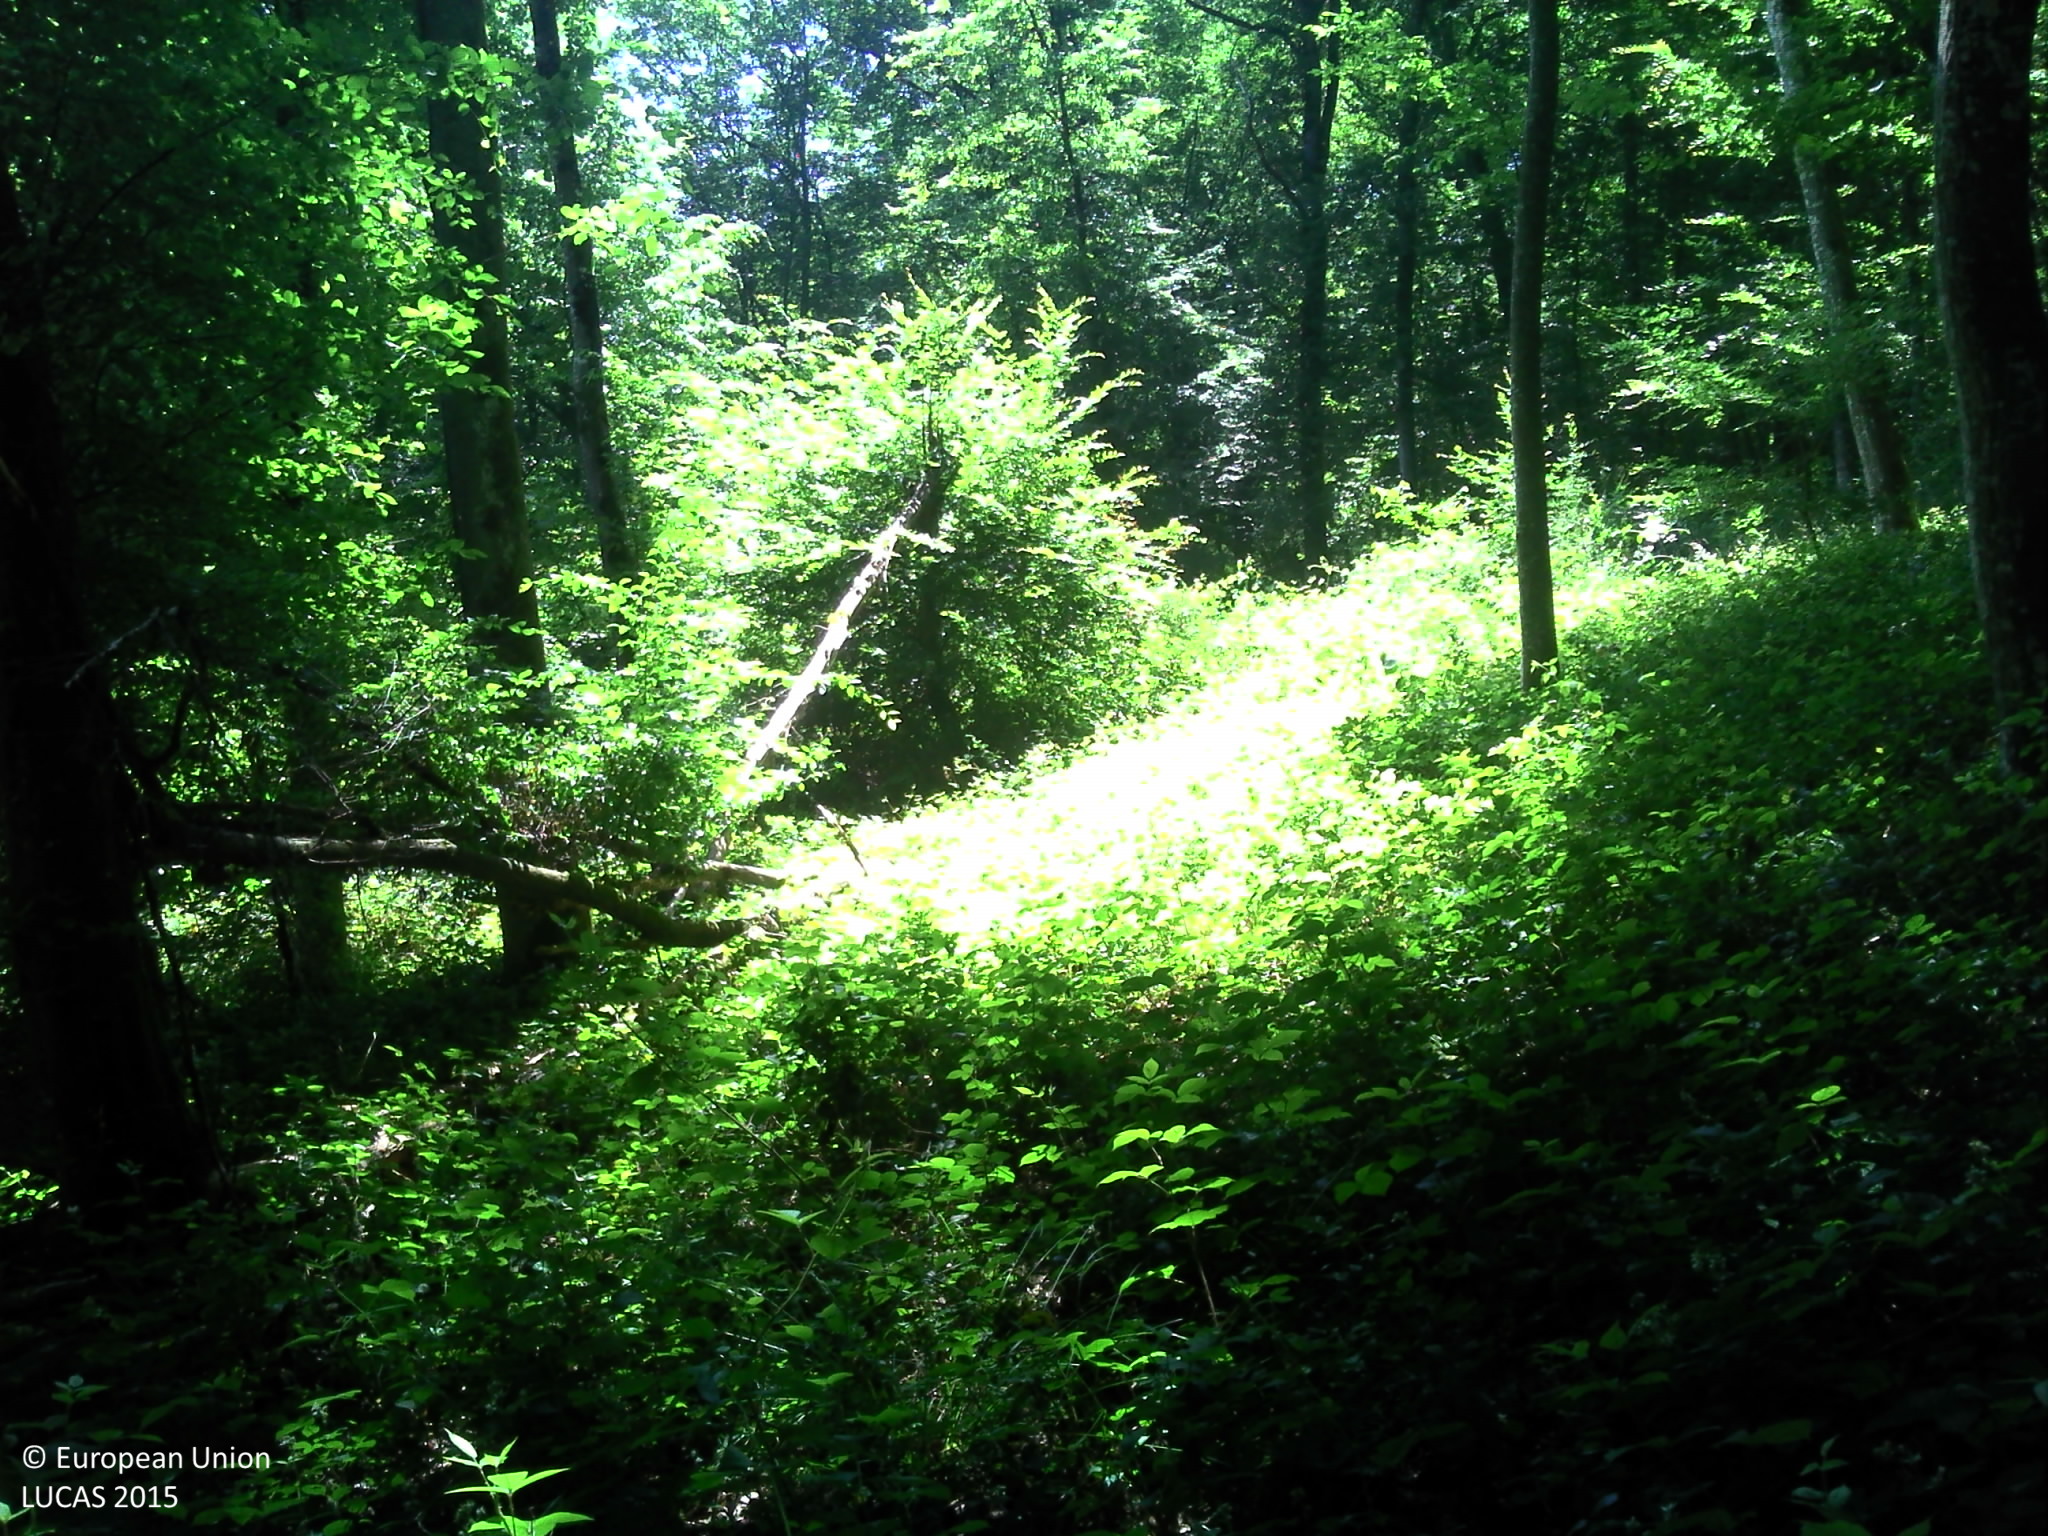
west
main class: Woodland
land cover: Broadleaved woodland
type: mesophytic deciduous forest
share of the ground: > 75 %
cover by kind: broadleaved forest trees 80 %, herbaceous plants 10 %, consolidated bare surface 10 %
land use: Forestry
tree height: > 5 m
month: June
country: FR
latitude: 49.1287
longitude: 1.0848
